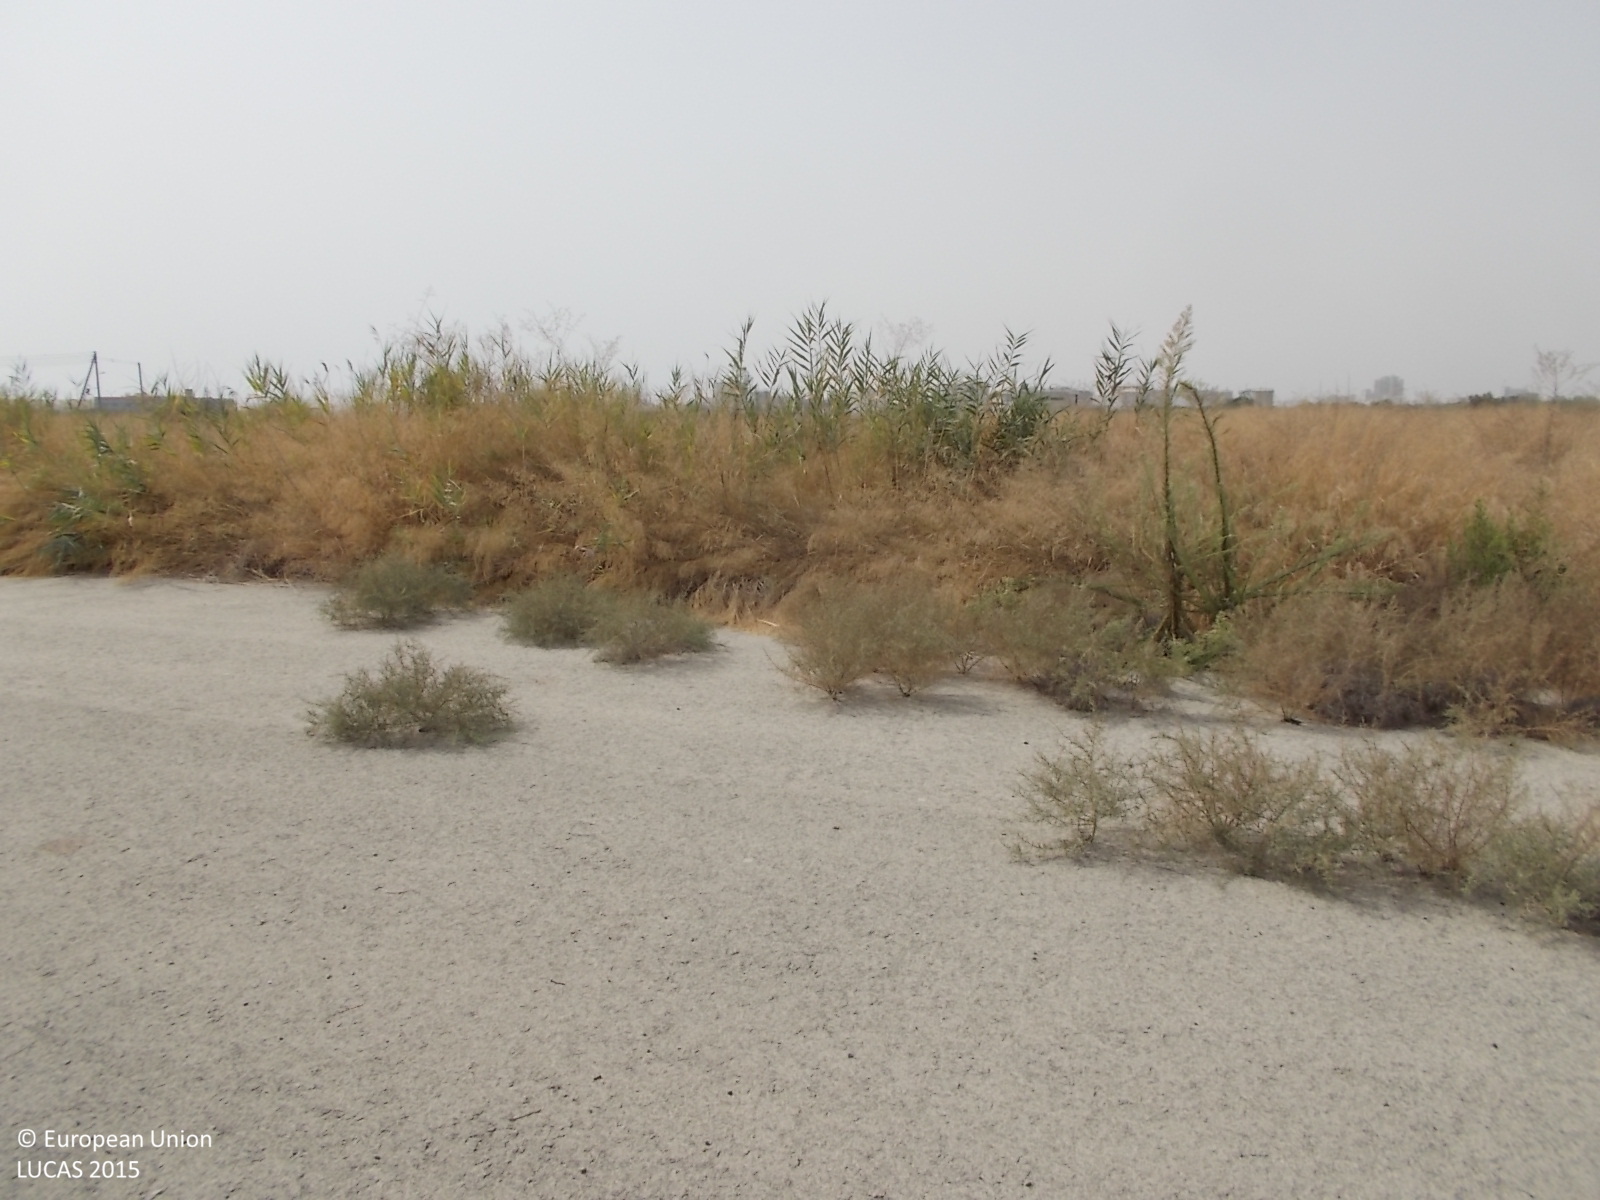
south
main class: Grassland
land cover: Spontaneously vegetated surfaces
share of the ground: > 75 %
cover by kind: herbaceous plants 100 %
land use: Abandoned areas
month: April
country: CY
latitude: 34.9468
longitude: 33.6412
